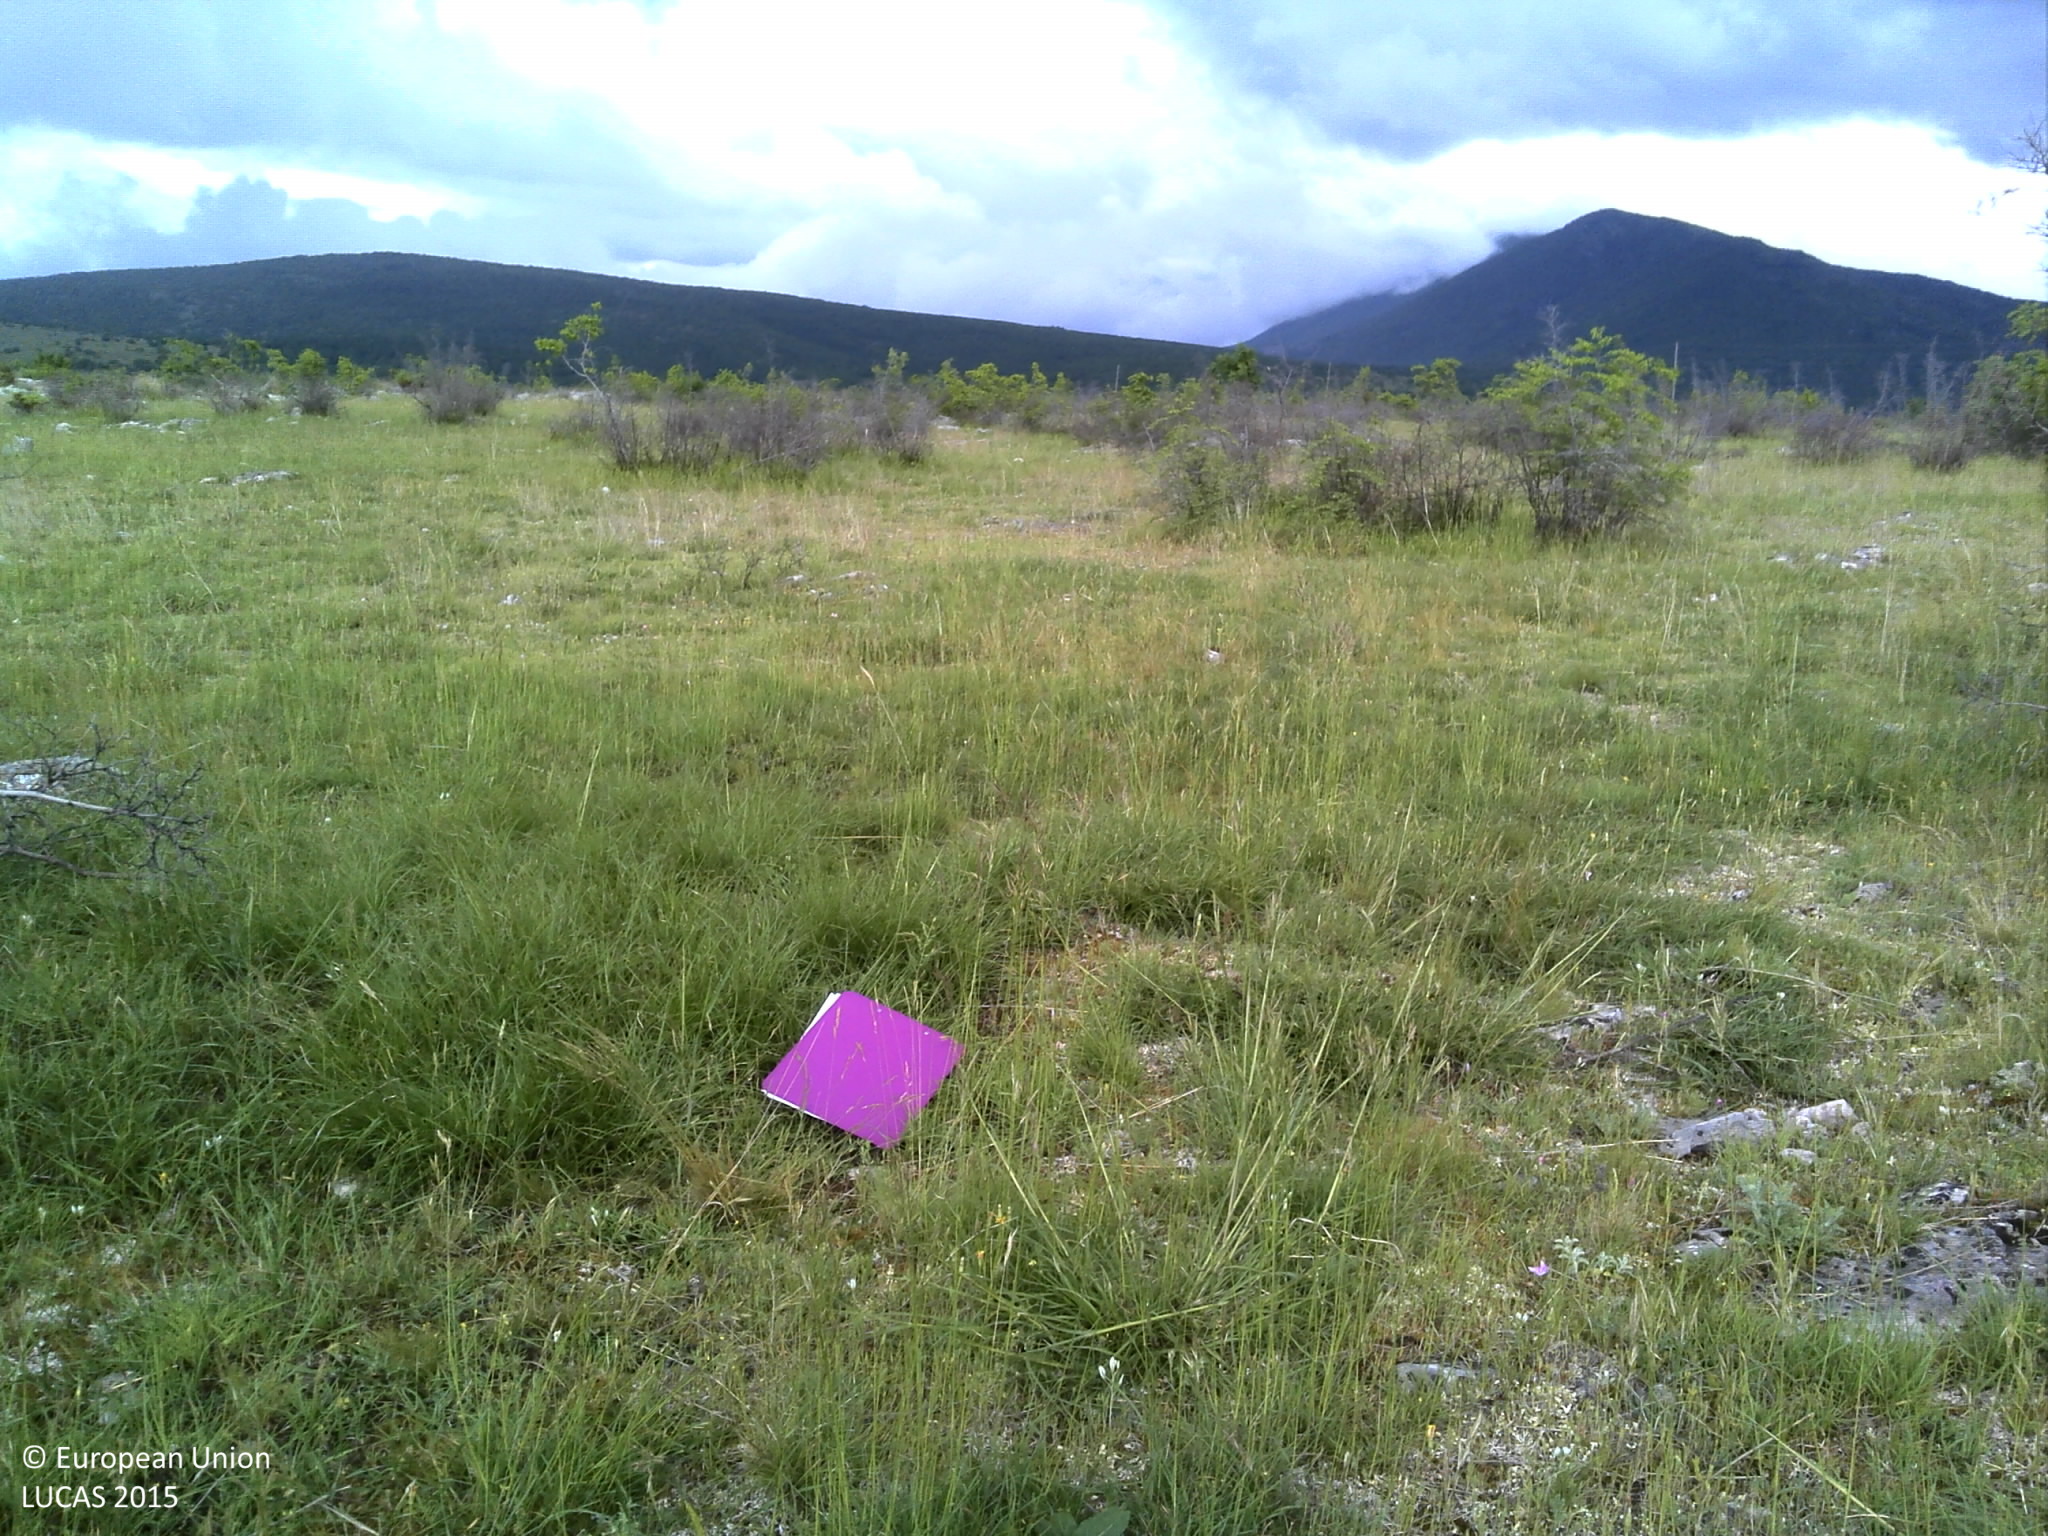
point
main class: Shrubland
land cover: Shrubland without tree cover
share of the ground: 10 - 25 %
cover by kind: herbaceous plants 75 %, shrubs 15 %, consolidated bare surface 5 %, unconsolidated bare surface 5 %
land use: Semi-natural and natural areas not in use
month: May
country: HR
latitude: 43.9819
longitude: 16.2384
